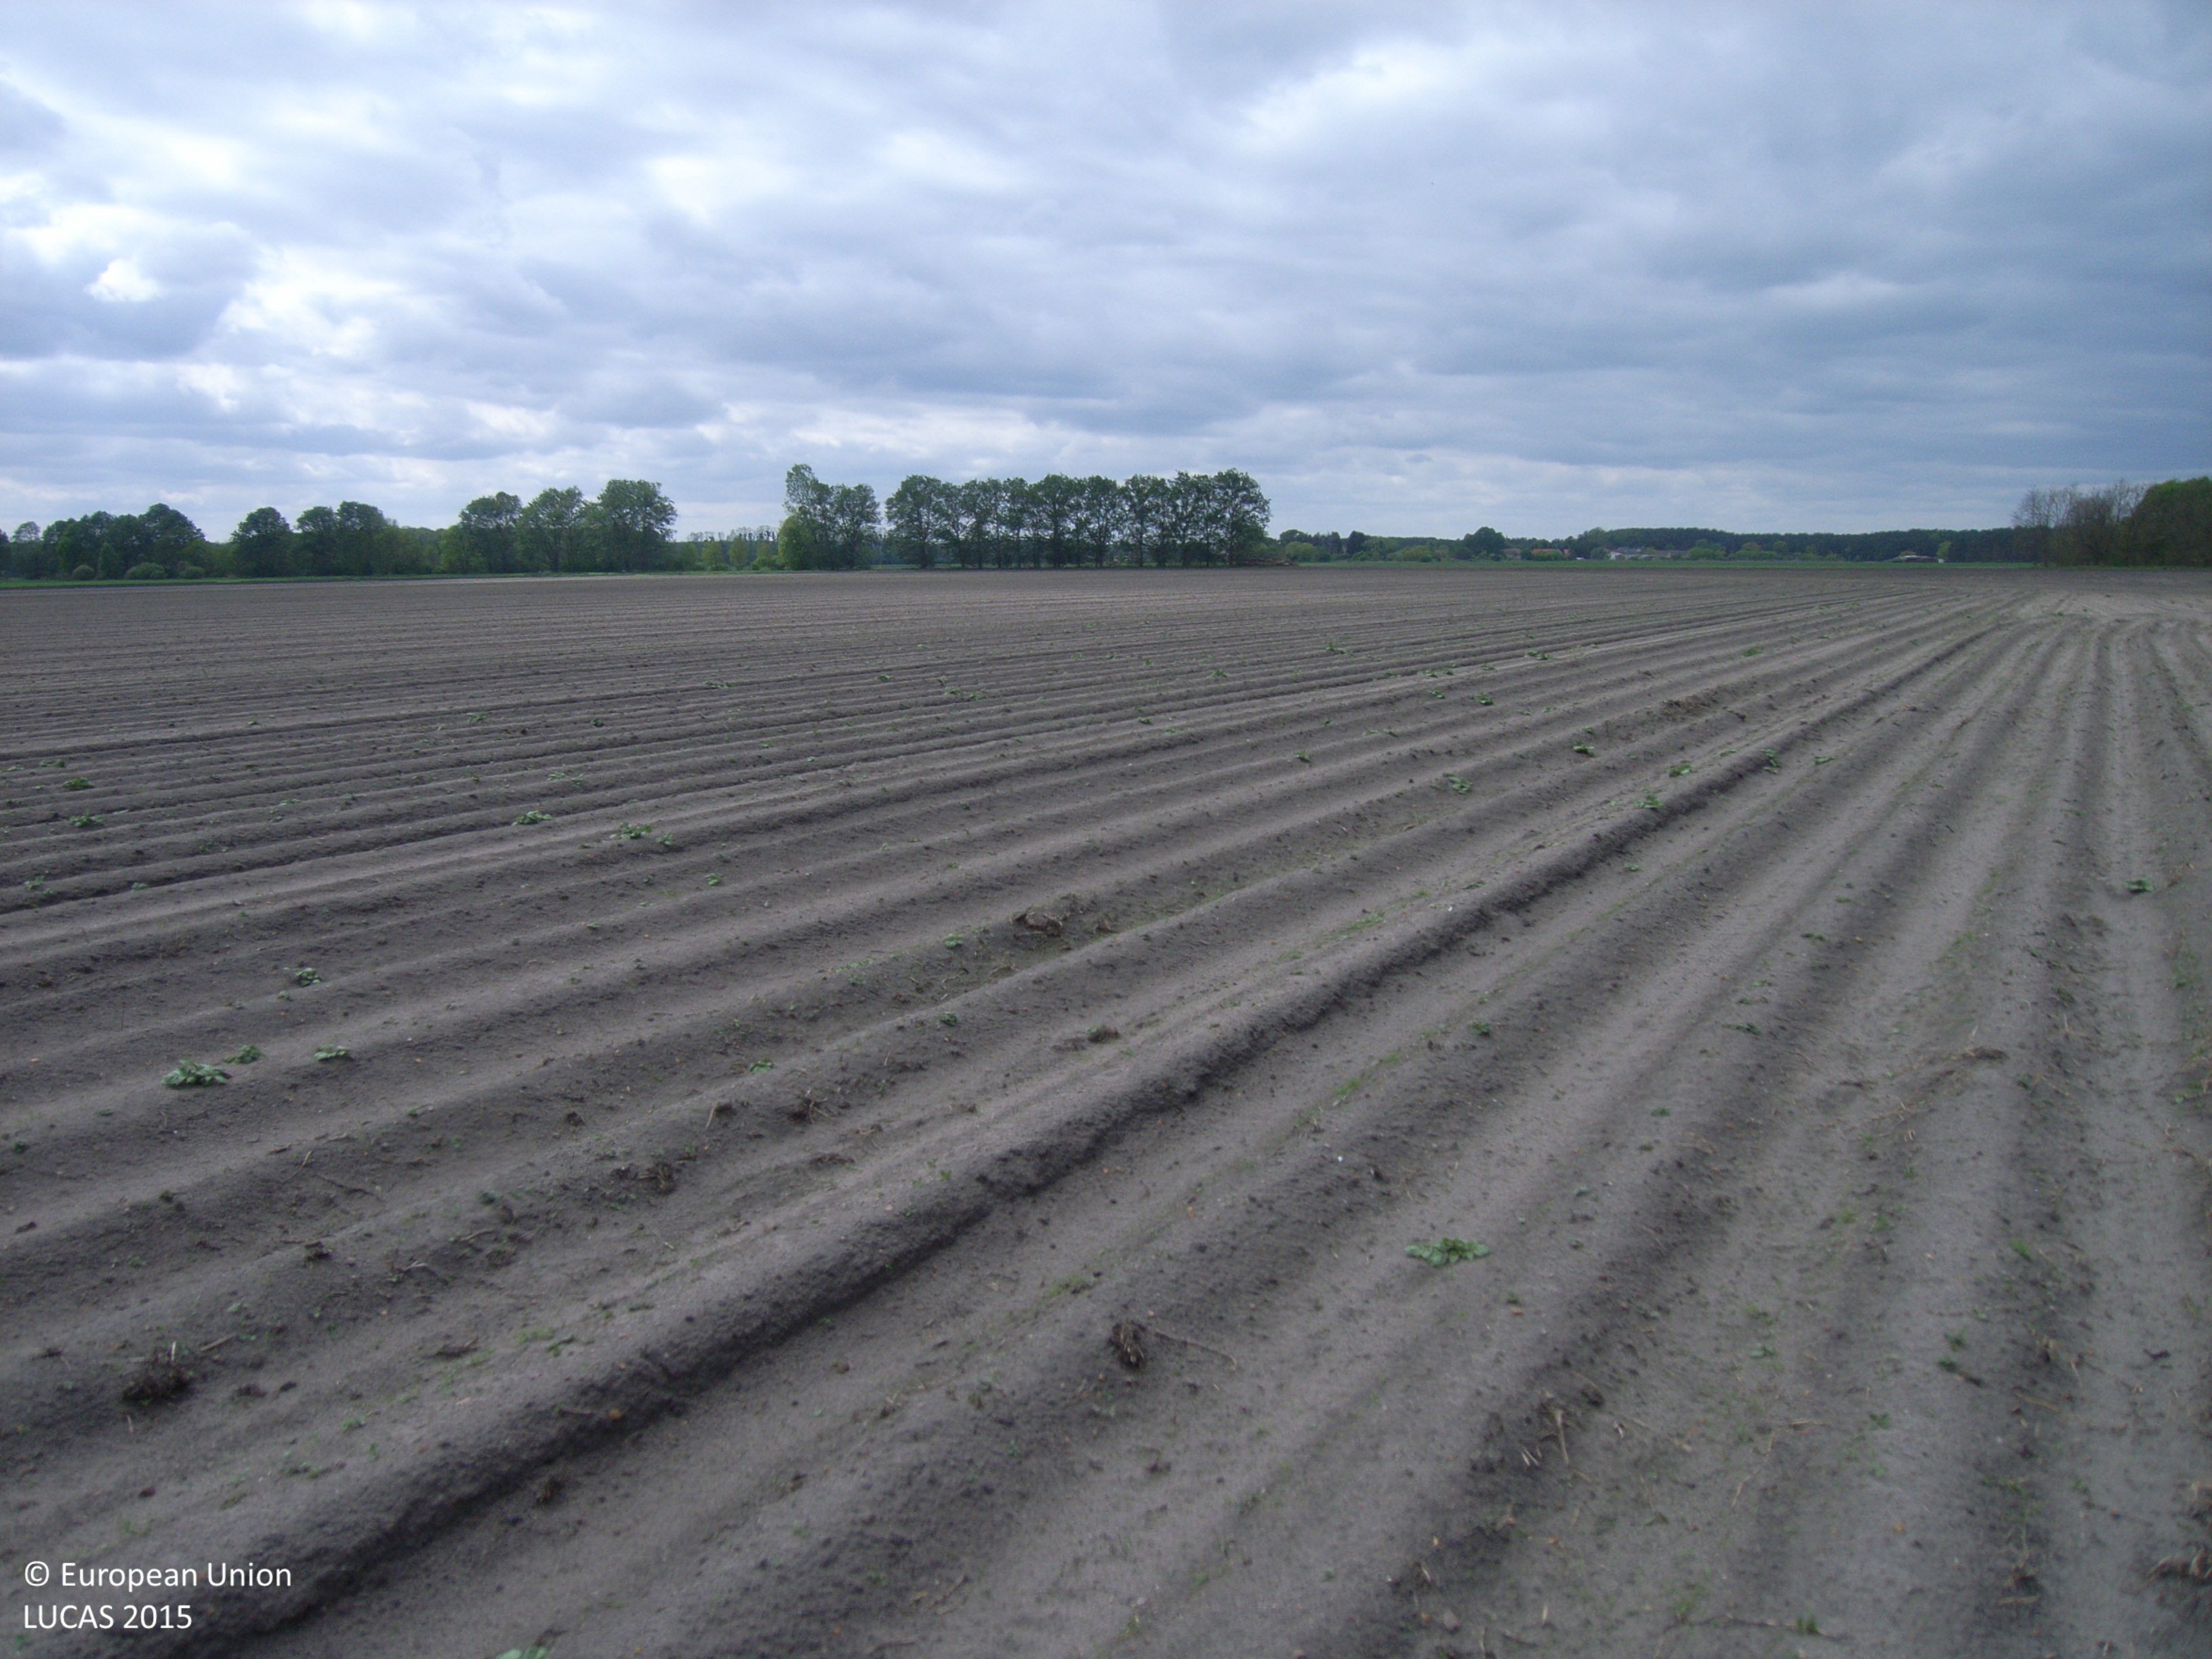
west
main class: Cropland
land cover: Potatoes
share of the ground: < 10 %
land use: Agriculture (excluding fallow land and kitchen gardens)
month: May
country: DE
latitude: 52.0538
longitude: 13.5733
